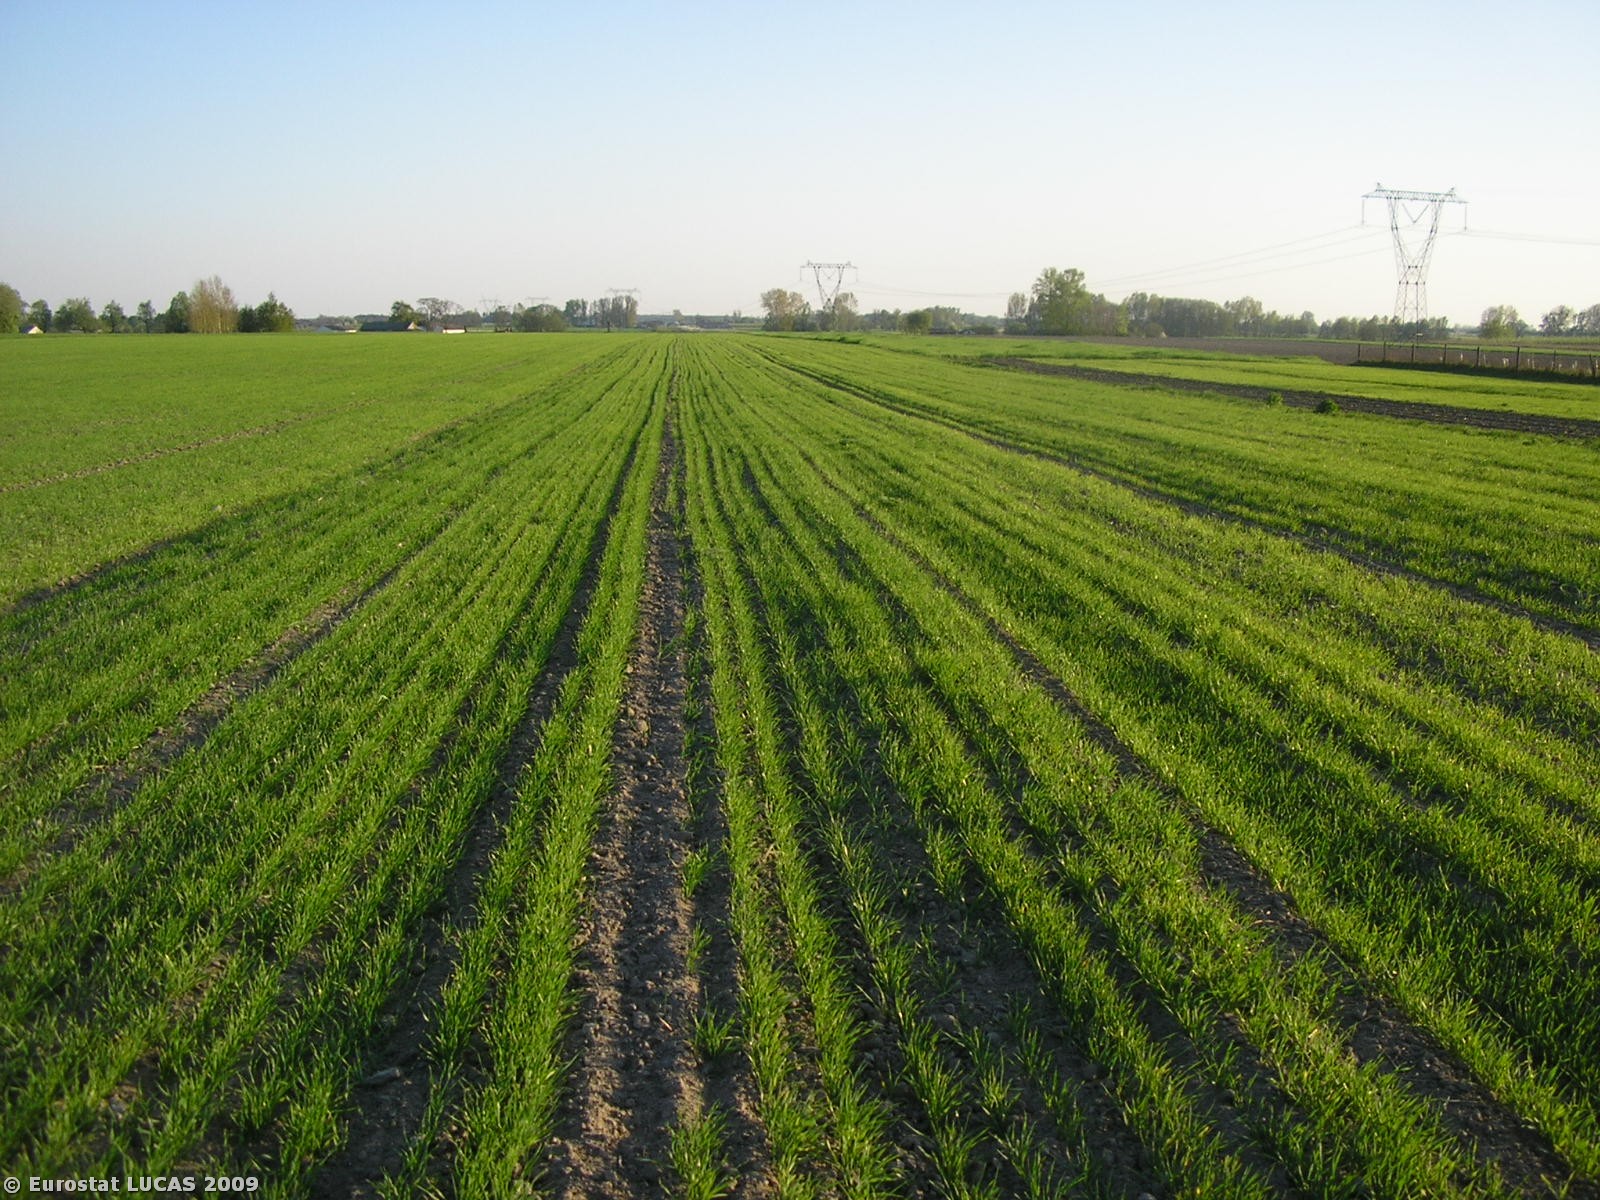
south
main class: Cropland
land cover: Mixed cereals for fodder
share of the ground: 25 - 50 %
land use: Agriculture (excluding fallow land and kitchen gardens)
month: April
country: PL
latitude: 52.2336
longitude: 20.1225
